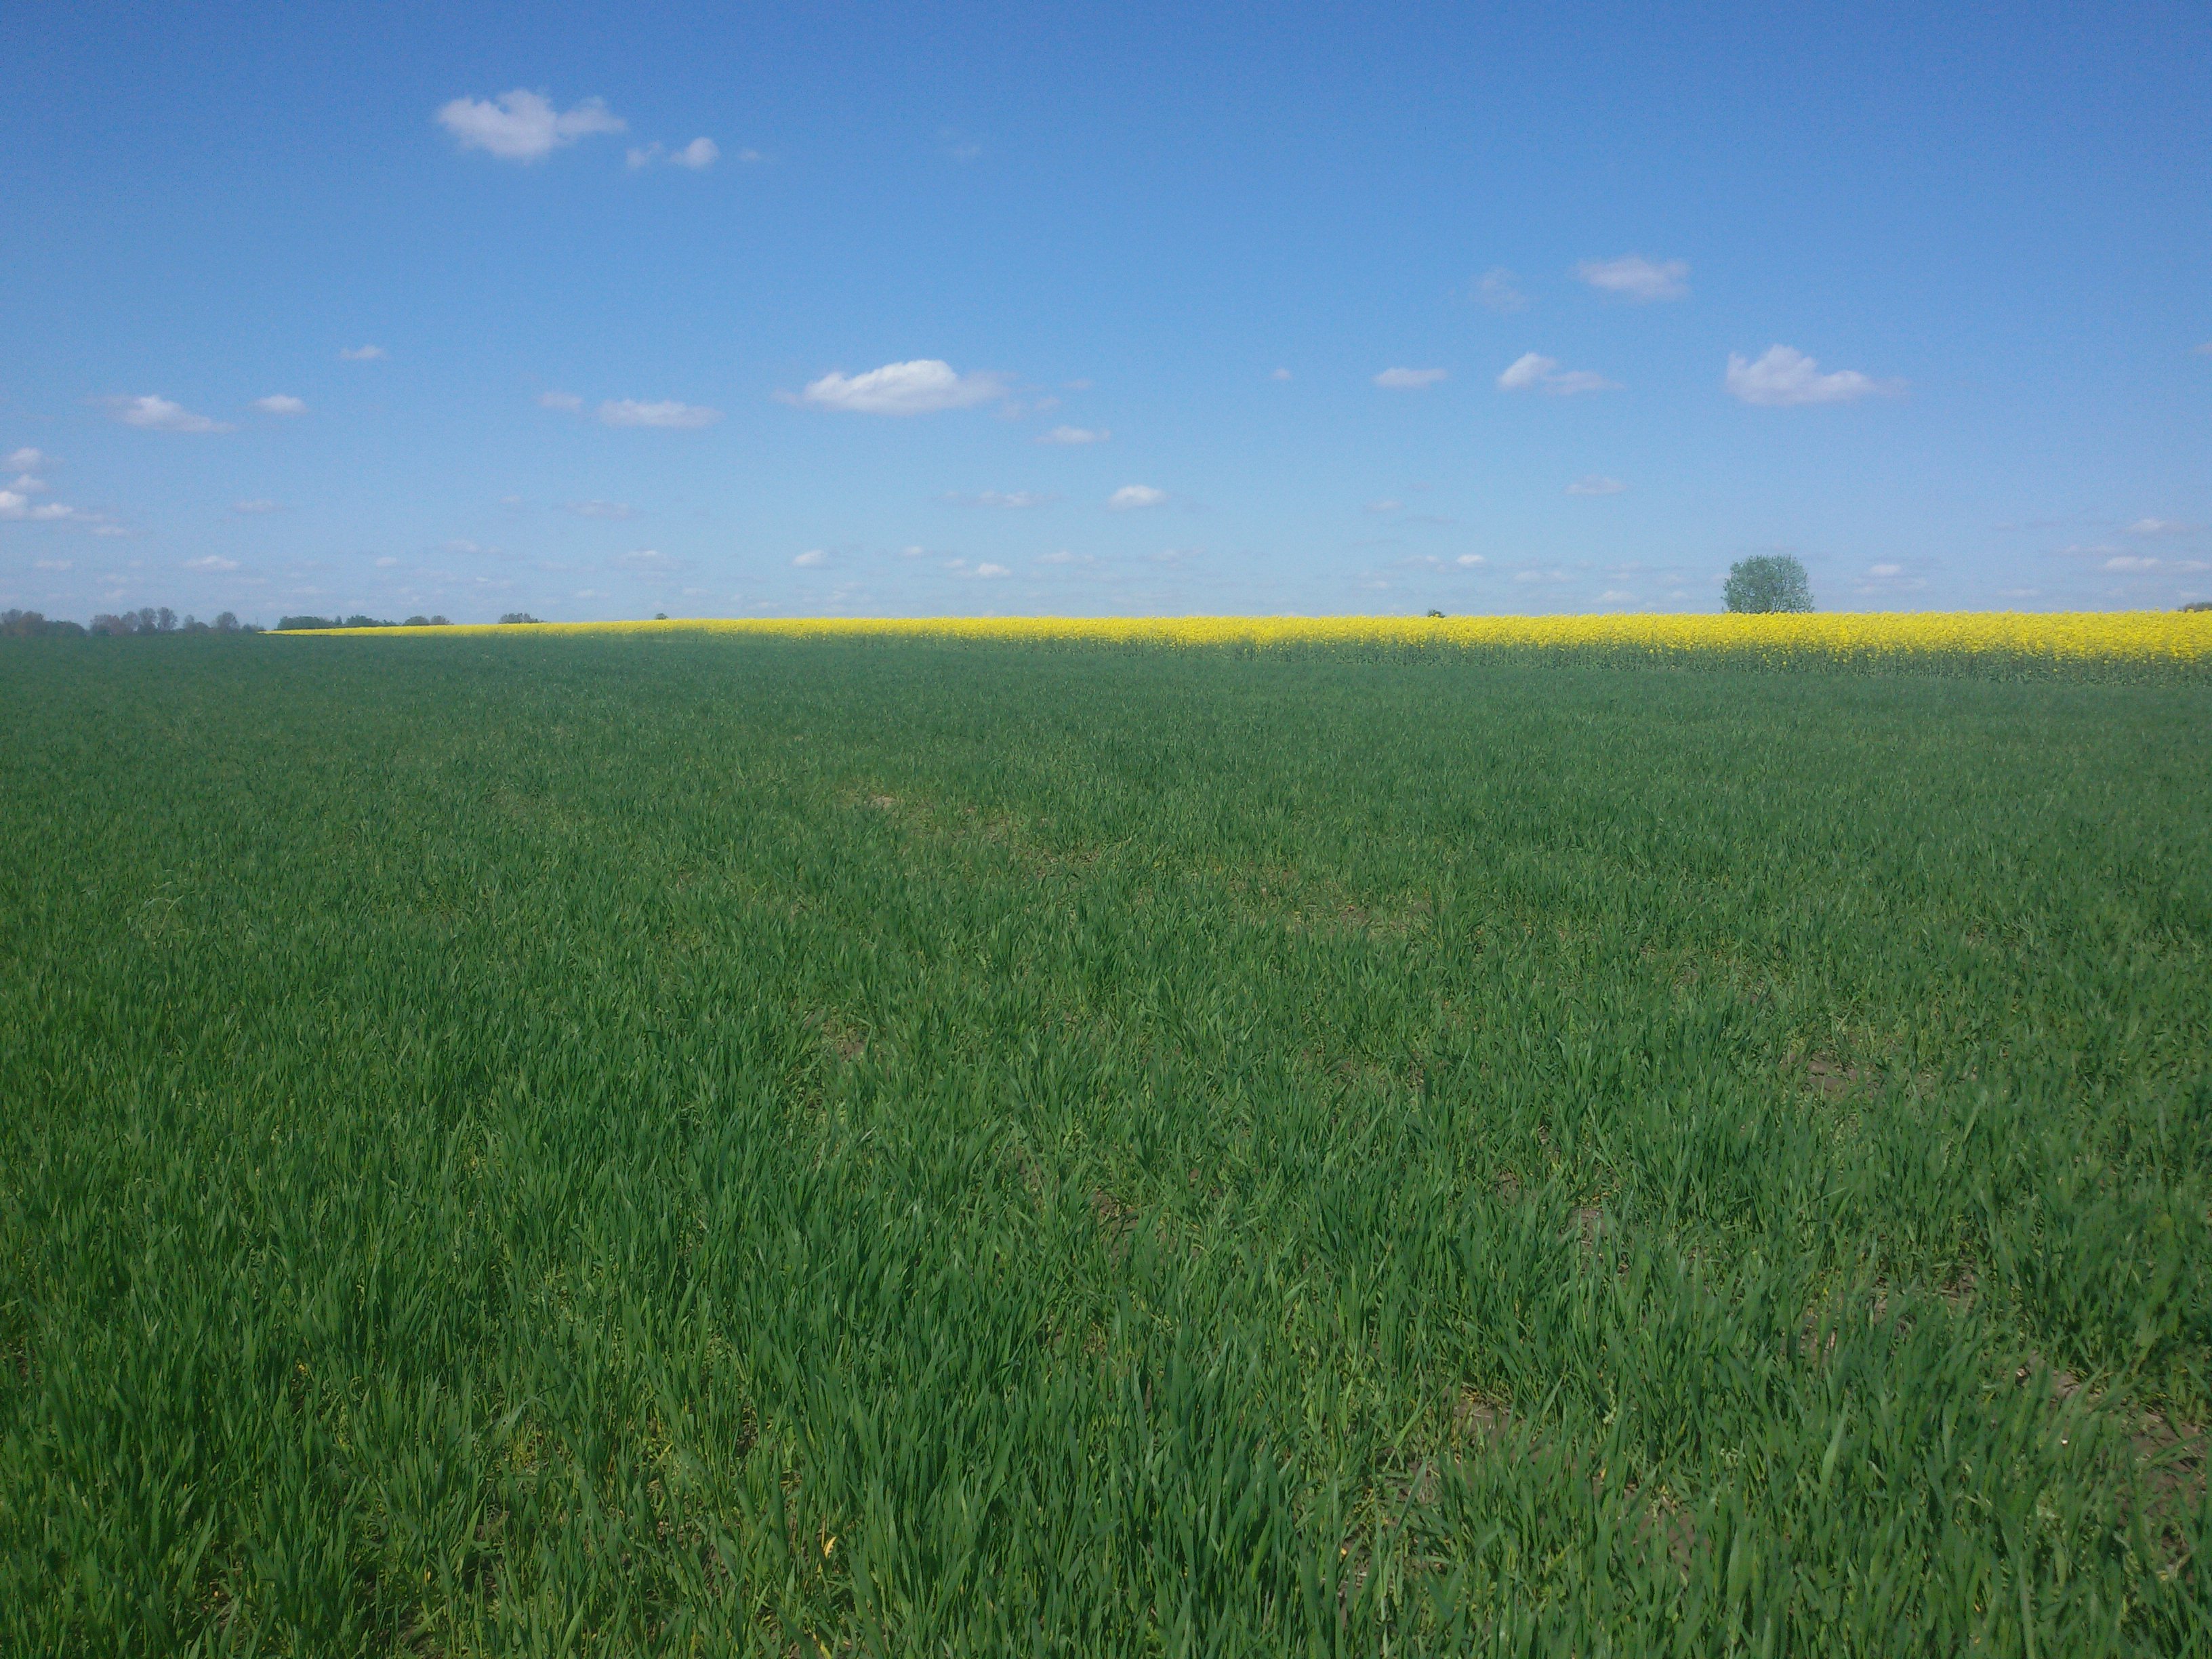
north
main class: Cropland
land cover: Oats
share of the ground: > 75 %
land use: Agriculture (excluding fallow land and kitchen gardens)
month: May
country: PL
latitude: 52.7995
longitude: 22.2087
